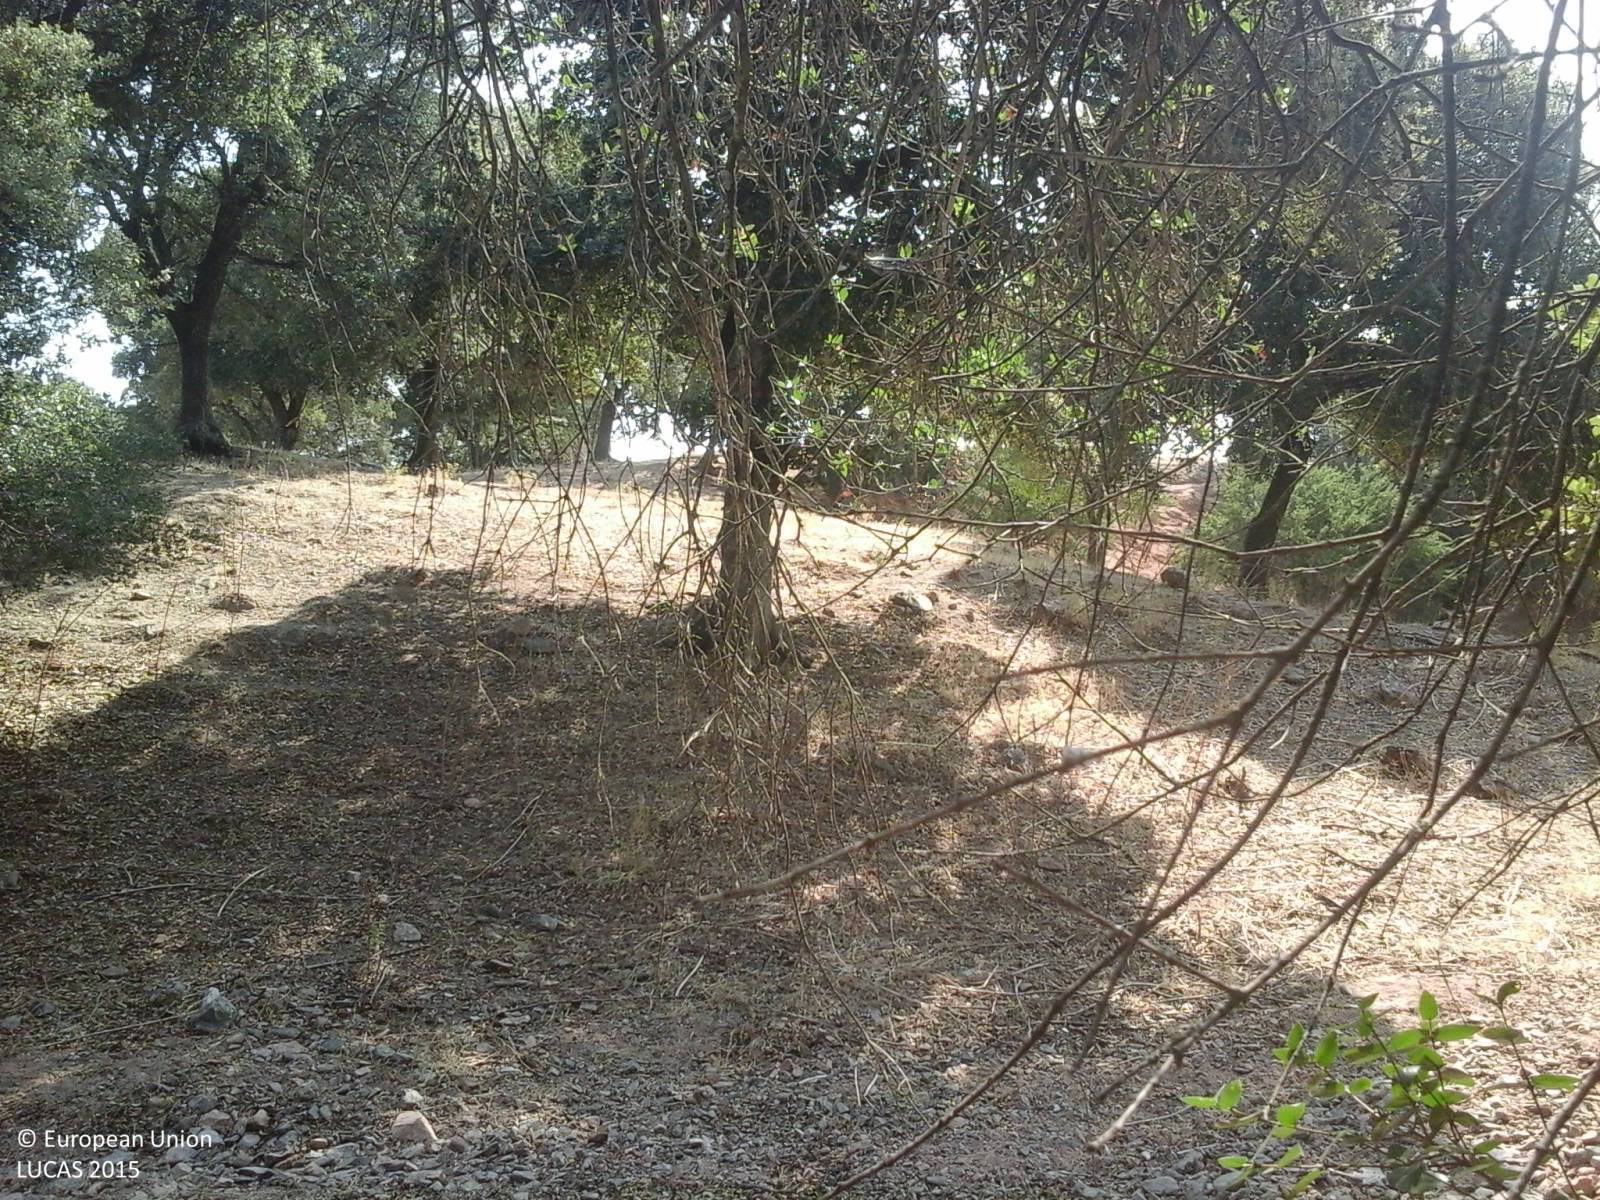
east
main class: Woodland
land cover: Broadleaved woodland
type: broadleaved evergreen forest
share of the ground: > 75 %
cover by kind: broadleaved forest trees 95 %, shrubs 5 %
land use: Forestry
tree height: > 5 m
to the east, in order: Broadleaved woodland; Ditches and canals; Fences; Grassland with sparse tree/shrub cover; Broadleaved woodland; Ditches and canals; Fences; Grassland without tree/shrub cover; Single bushes/trees; Grassland without tree/shrub cover
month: July
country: IT
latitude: 40.7729
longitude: 9.5166
